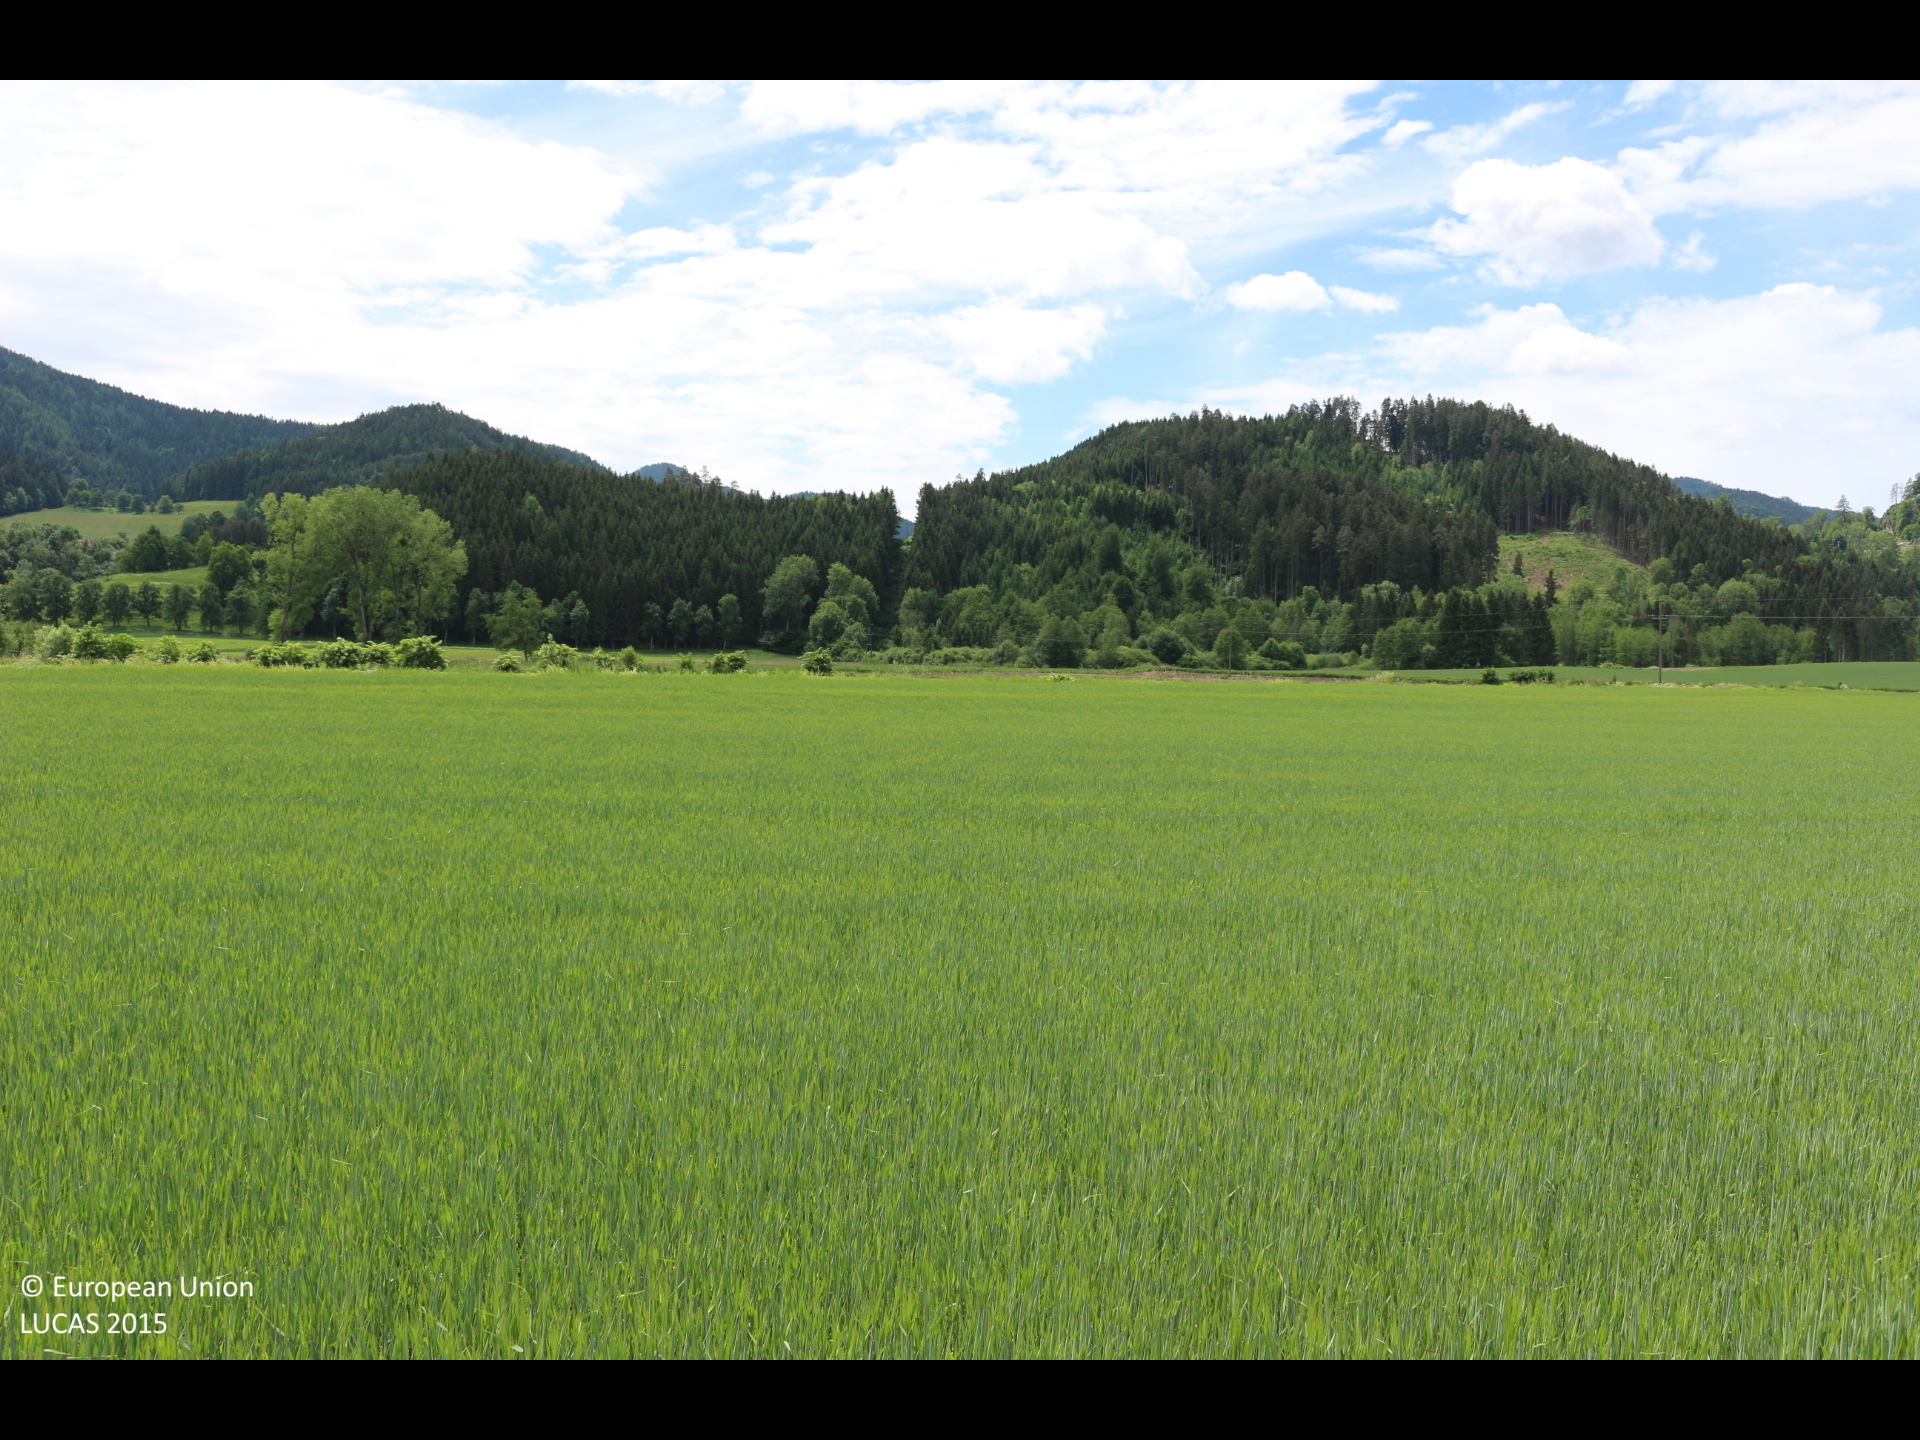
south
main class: Cropland
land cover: Triticale
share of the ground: > 75 %
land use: Agriculture (excluding fallow land and kitchen gardens)
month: May
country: AT
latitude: 46.7631
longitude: 14.4627
